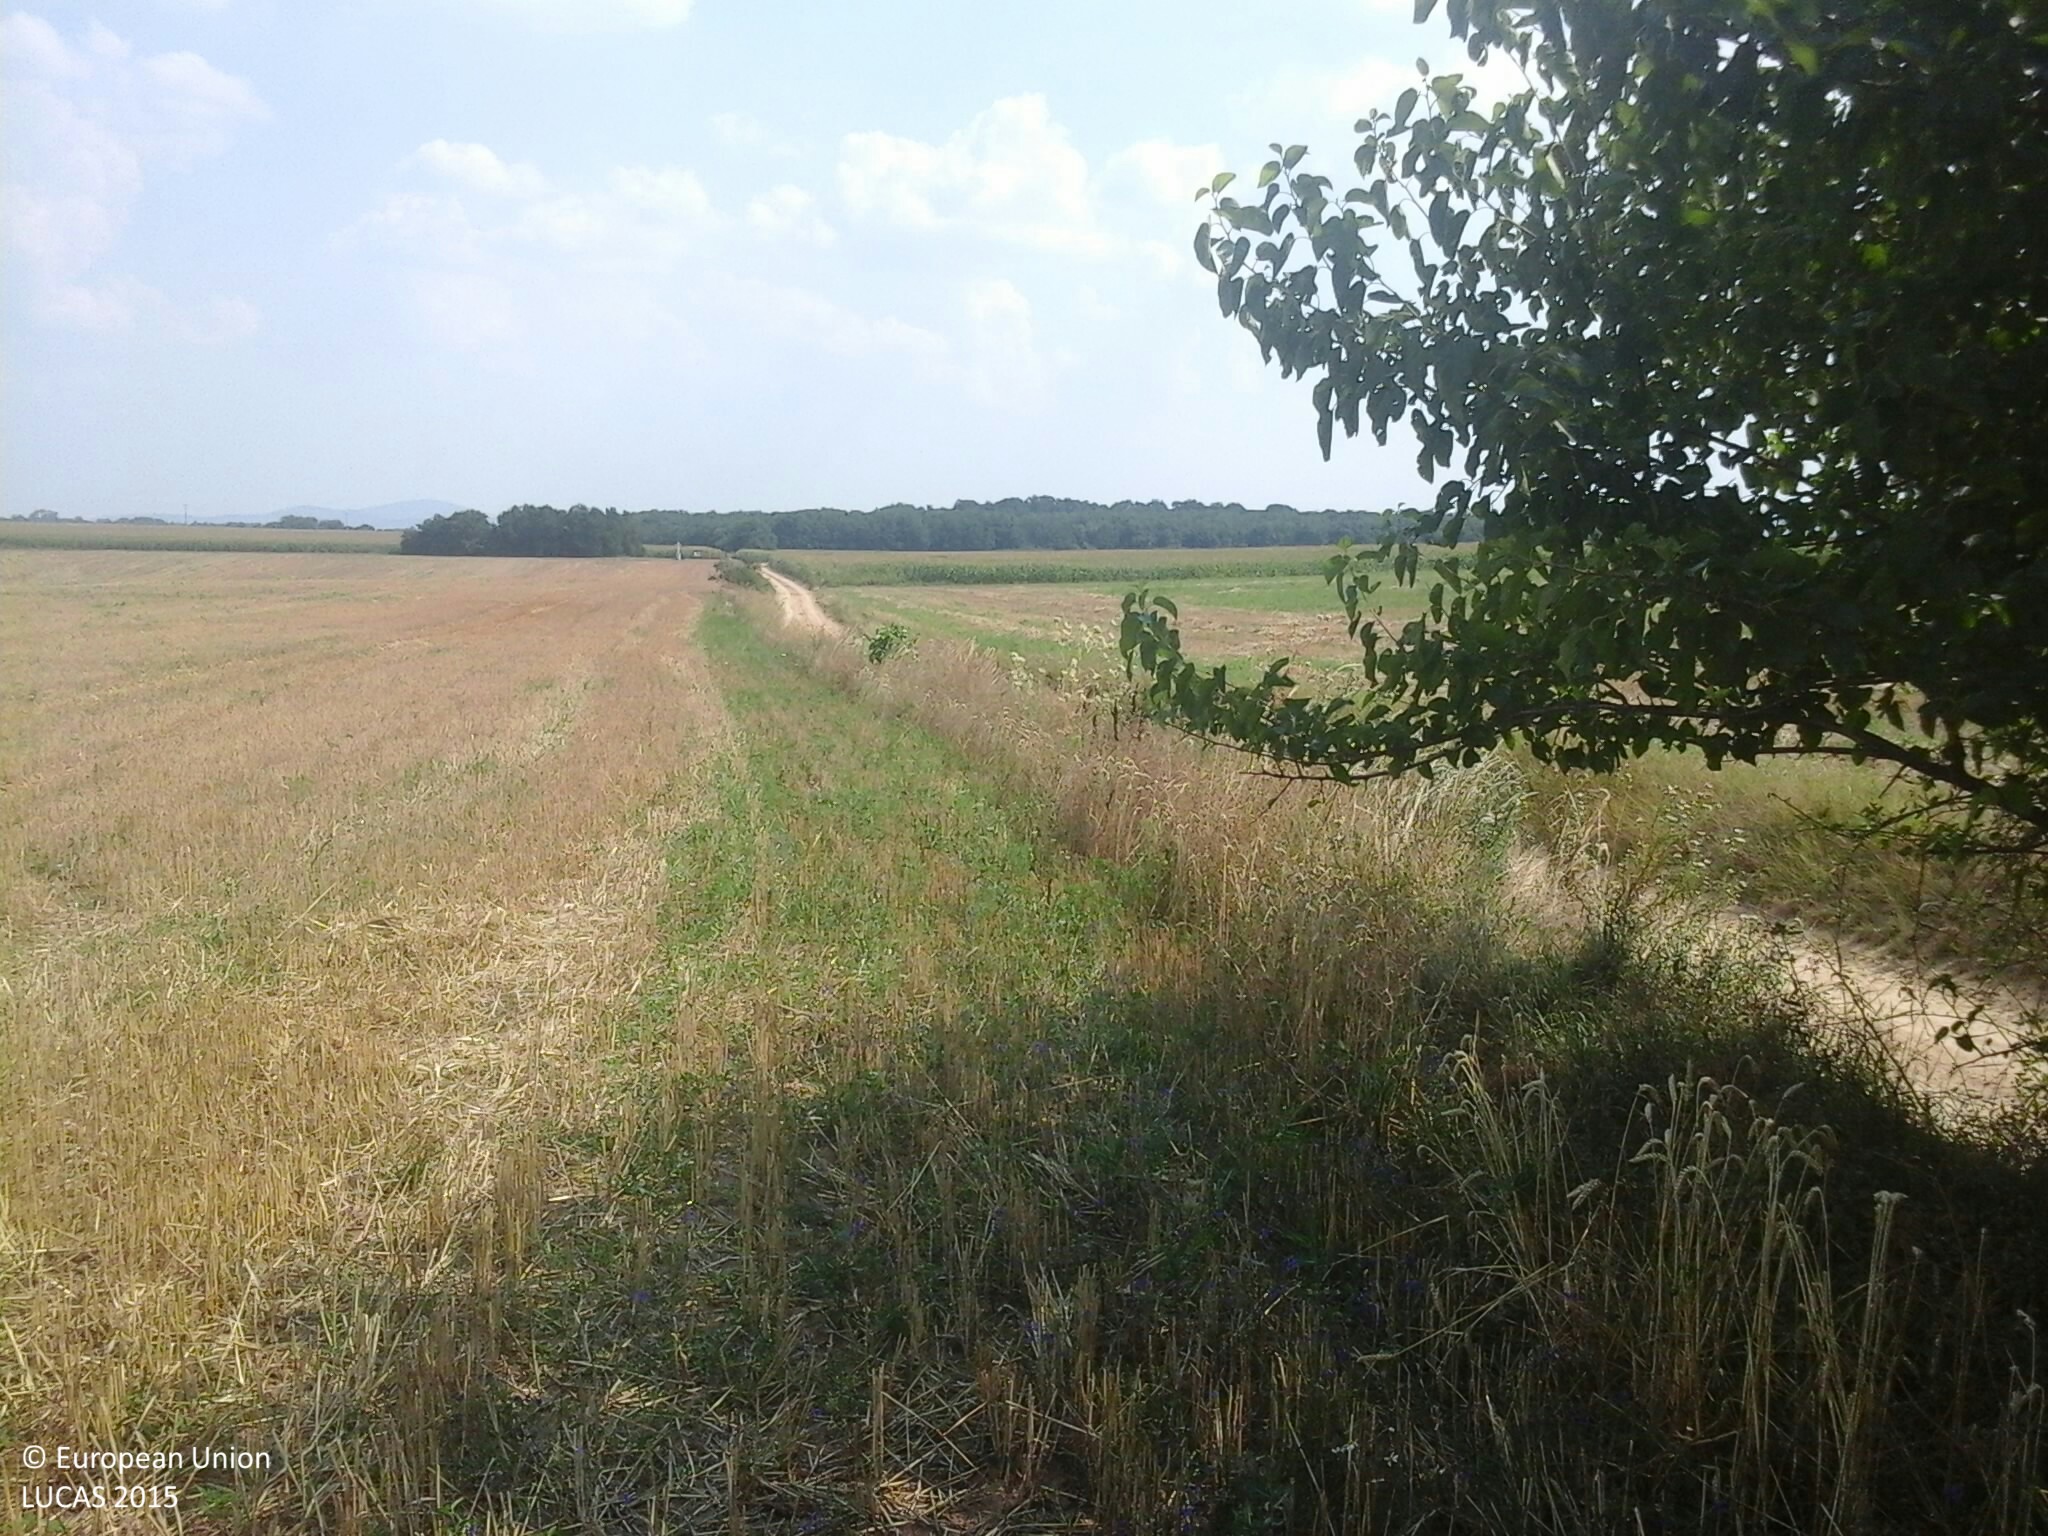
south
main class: Cropland
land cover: Common wheat
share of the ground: 10 - 25 %
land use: Agriculture (excluding fallow land and kitchen gardens)
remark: Harvested field
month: August
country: HU
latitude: 45.9774
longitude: 18.2546
